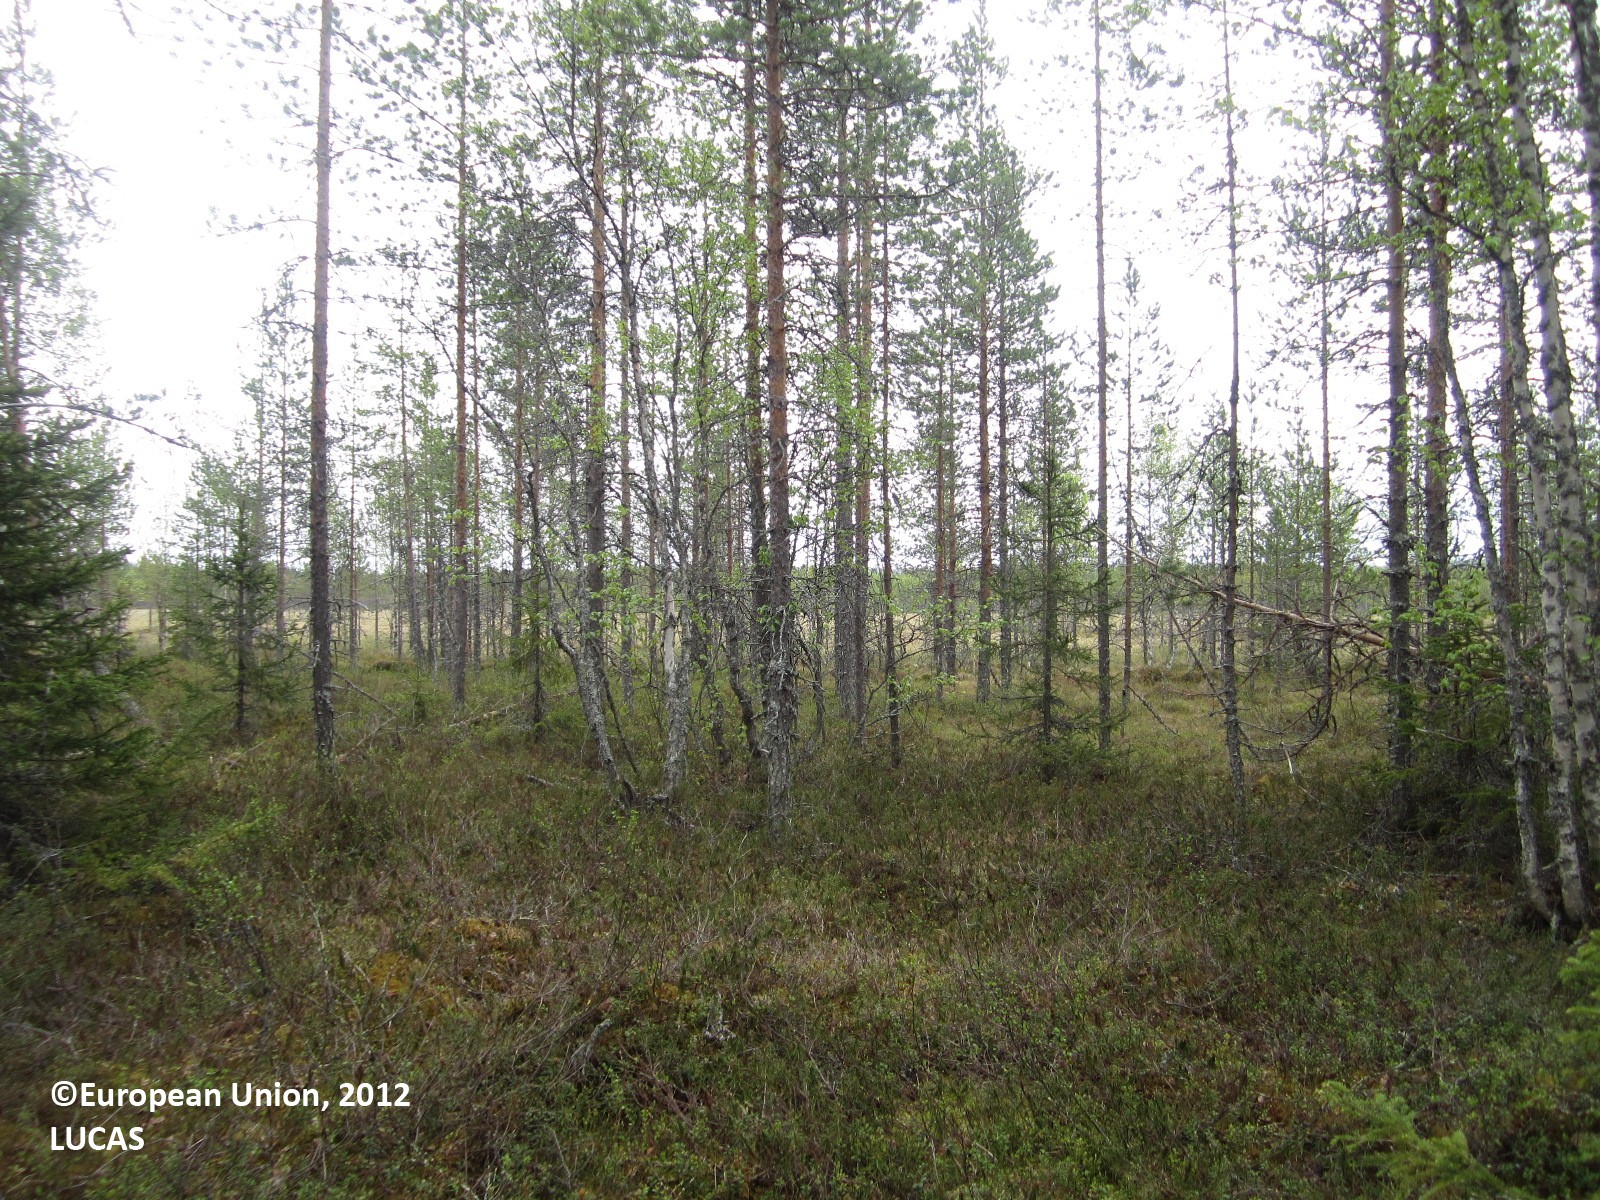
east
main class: Woodland
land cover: Pine dominated mixed woodland
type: boreal forest
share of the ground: > 75 %
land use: Forestry
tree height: > 5 m
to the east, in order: Pine dominated mixed woodland; Pine dominated coniferous woodland; Spruce dominated mixed woodland; Other mixed woodland; Peatbogs
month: June
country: FI
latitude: 64.7996
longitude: 28.7241
